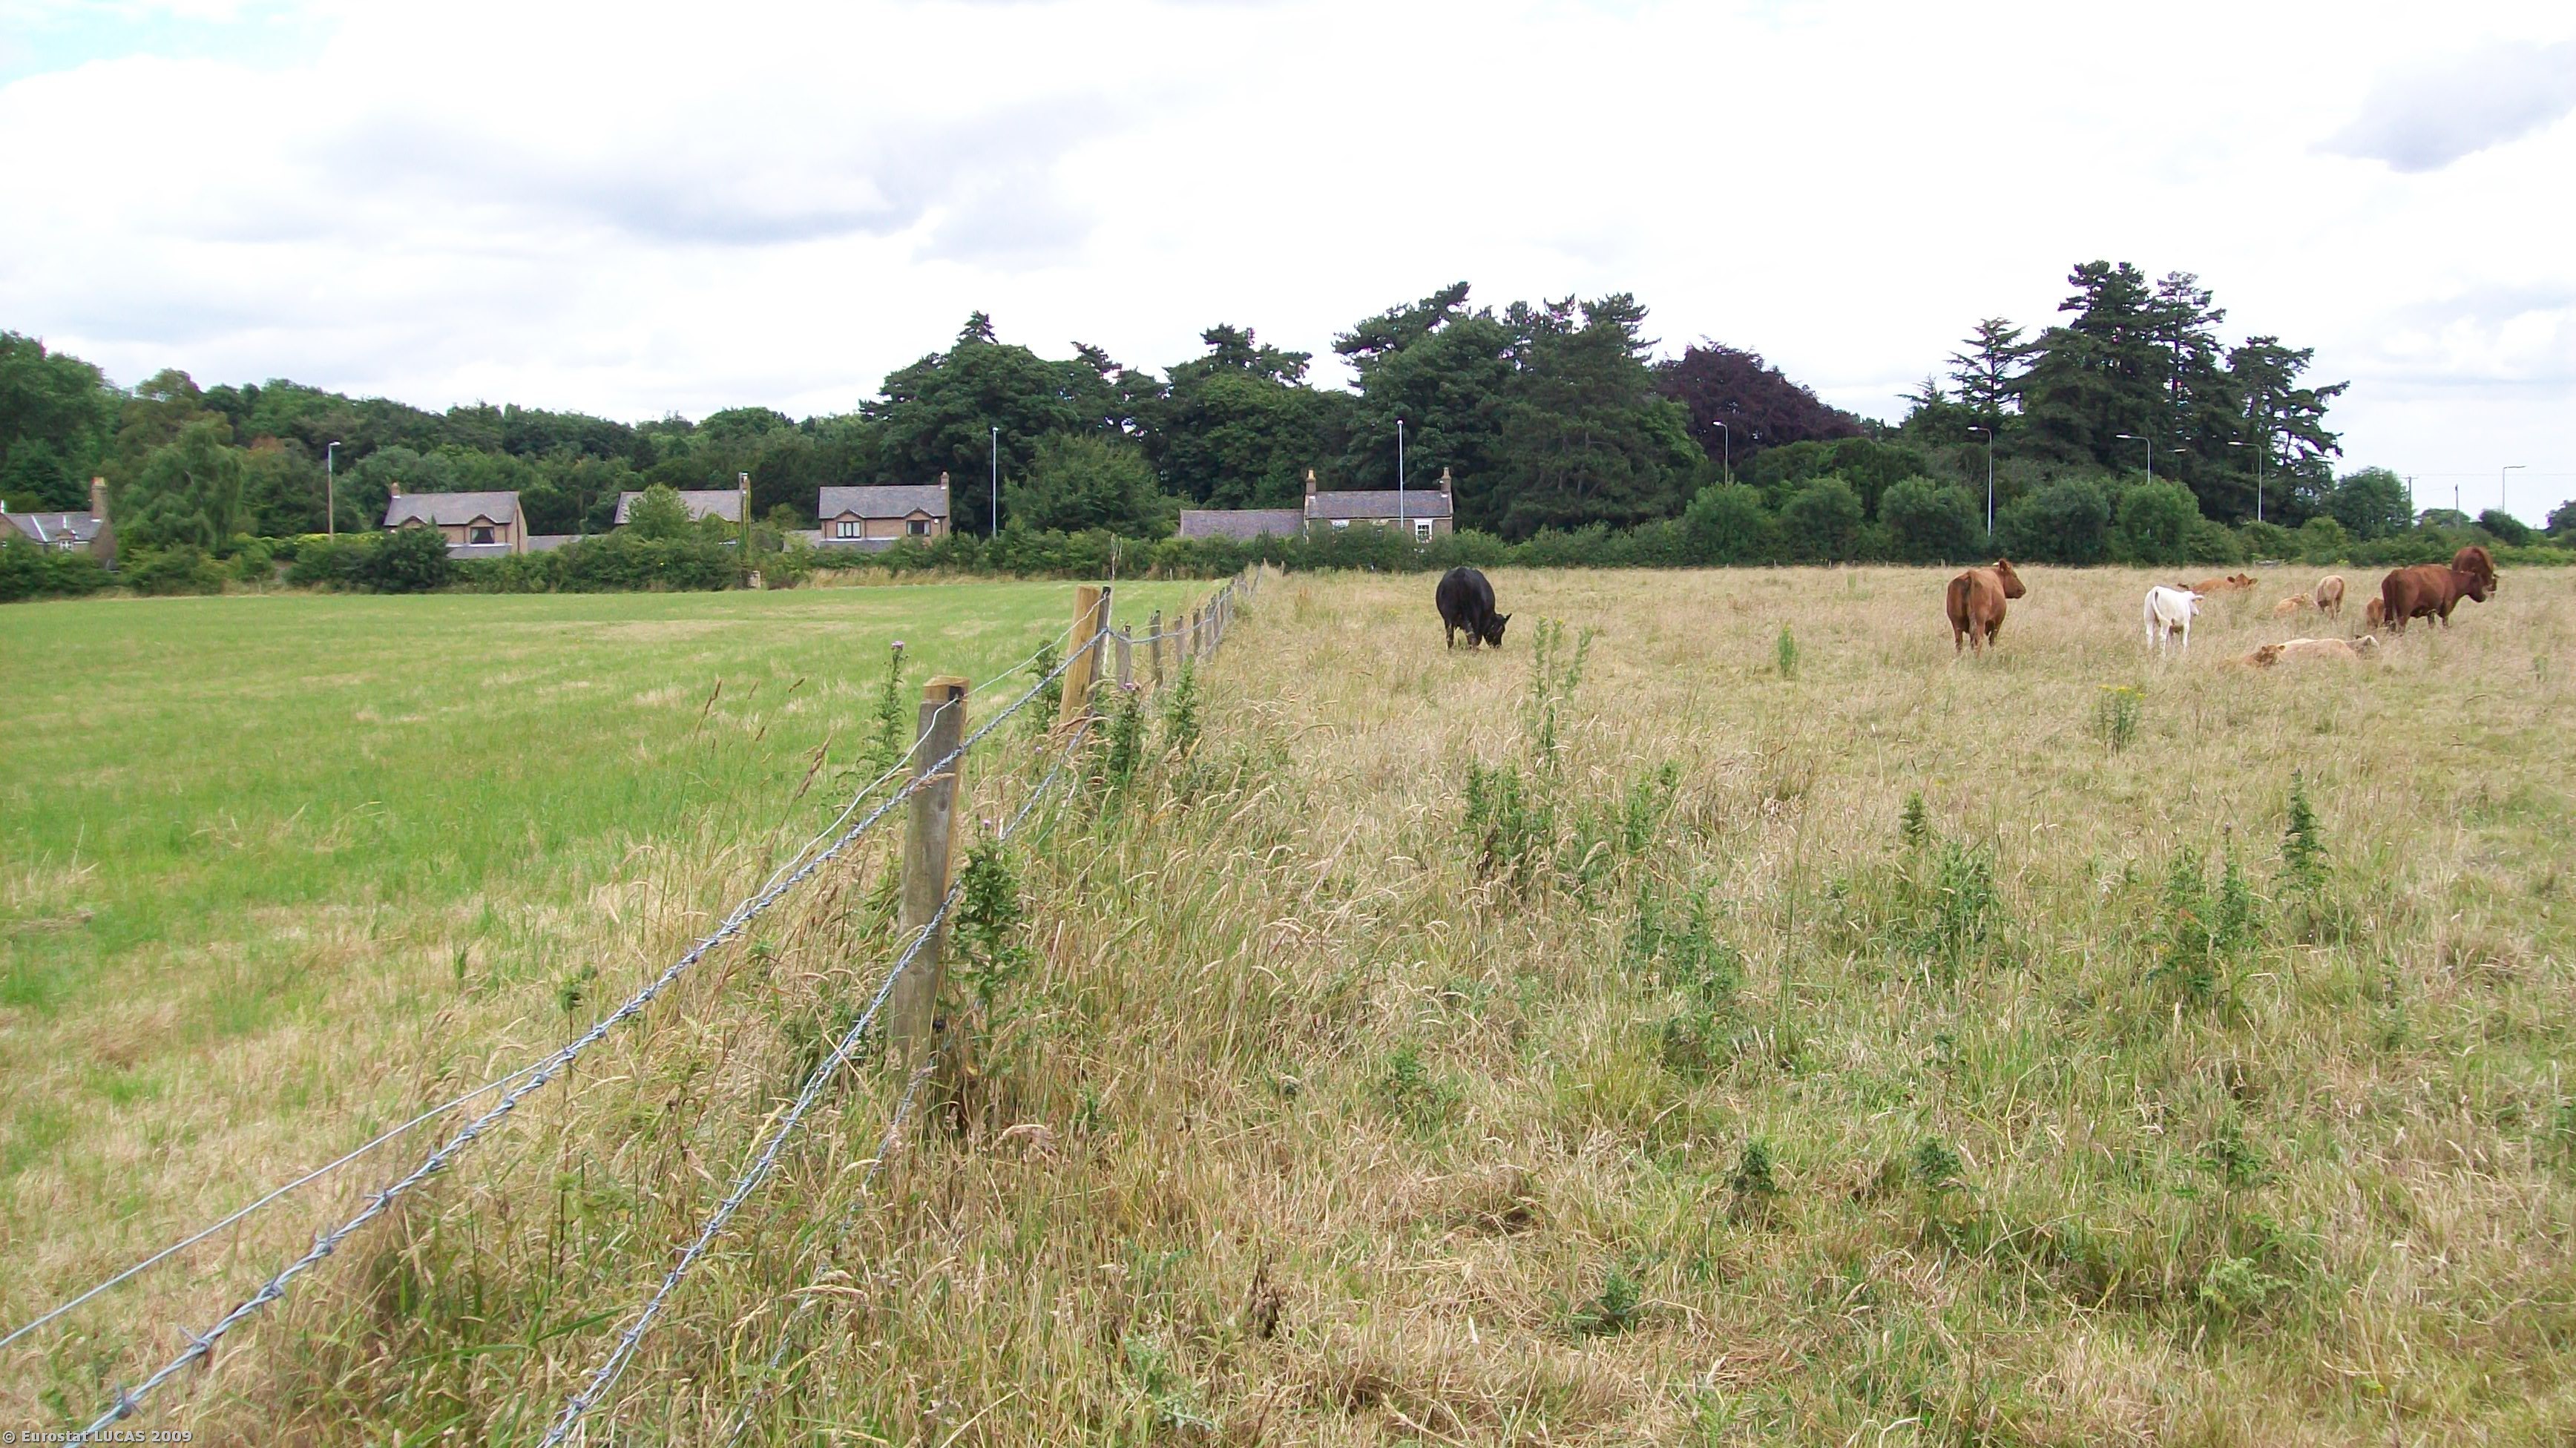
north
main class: Cropland
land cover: Temporary grasslands
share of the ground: > 75 %
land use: Agriculture (excluding fallow land and kitchen gardens)
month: July
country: GB
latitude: 53.5611
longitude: -0.2857
